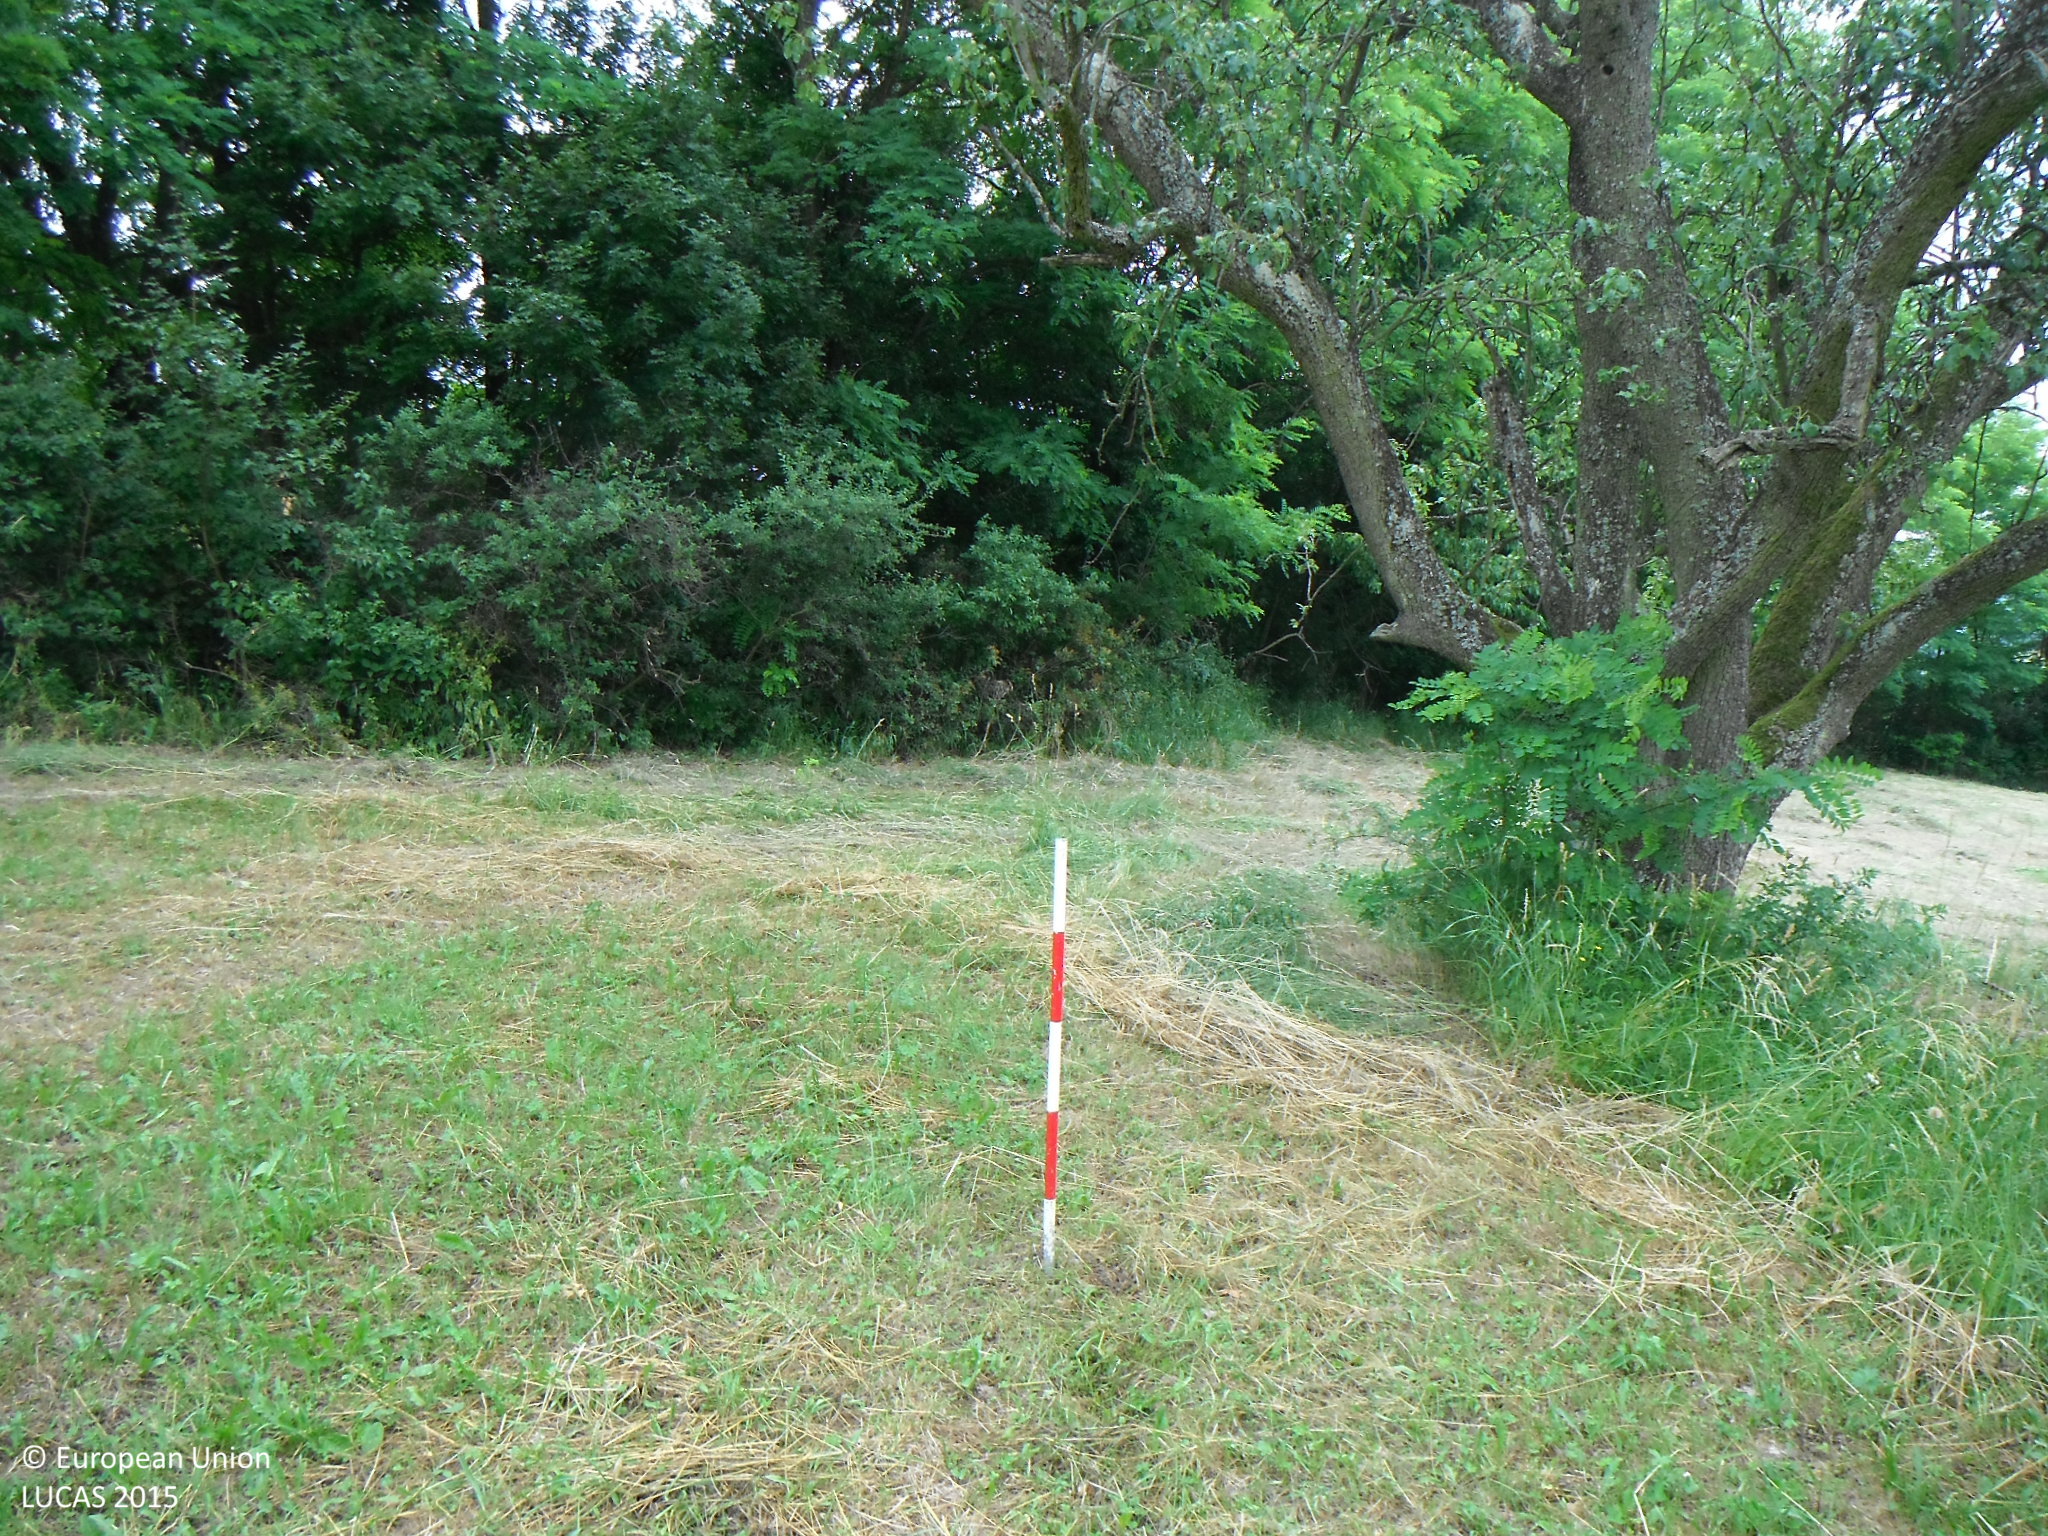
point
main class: Cropland
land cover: Pear fruit
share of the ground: 25 - 50 %
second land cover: Grassland without tree/shrub cover
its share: > 75 %
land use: Kitchen garden
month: June
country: SK
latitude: 48.2283
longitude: 19.2976
